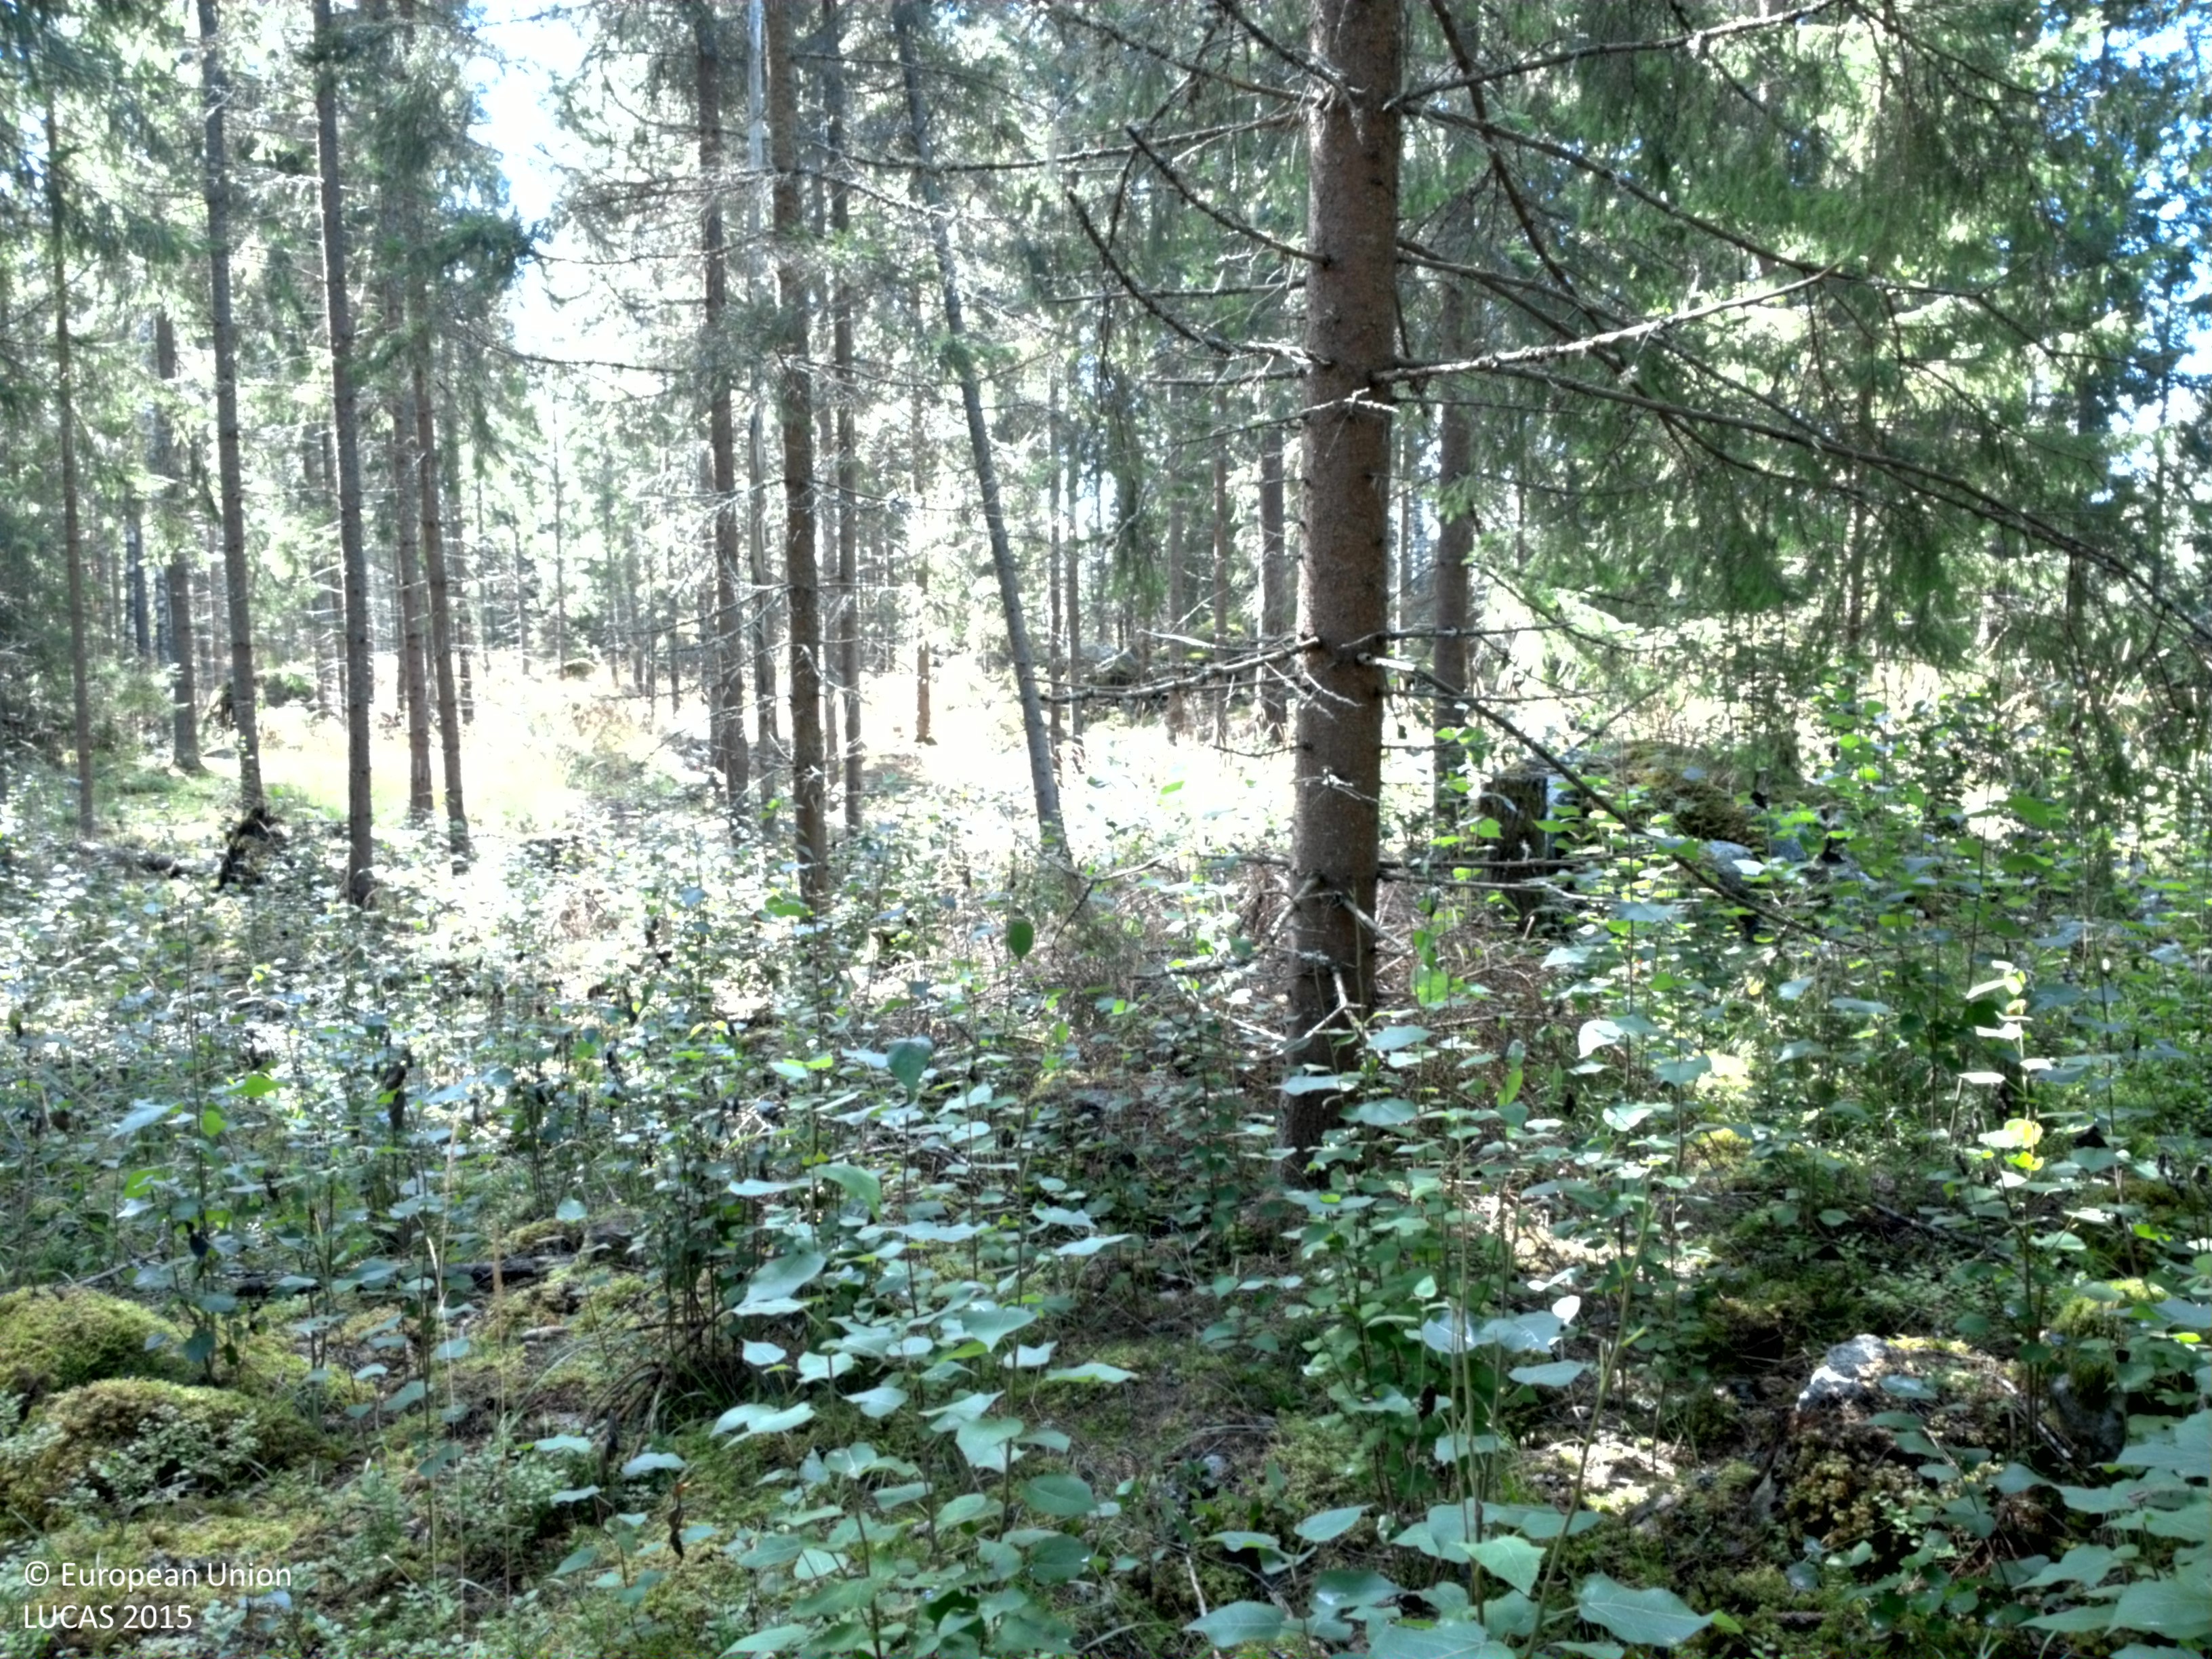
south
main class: Woodland
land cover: Spruce dominated coniferous woodland
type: boreal forest
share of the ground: > 75 %
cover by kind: coniferous forest trees 75 %, lichens and mosses 15 %, broadleaved forest trees 5 %, shrubs 5 %
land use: Forestry
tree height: > 5 m
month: August
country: SE
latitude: 59.8954
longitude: 16.3001
